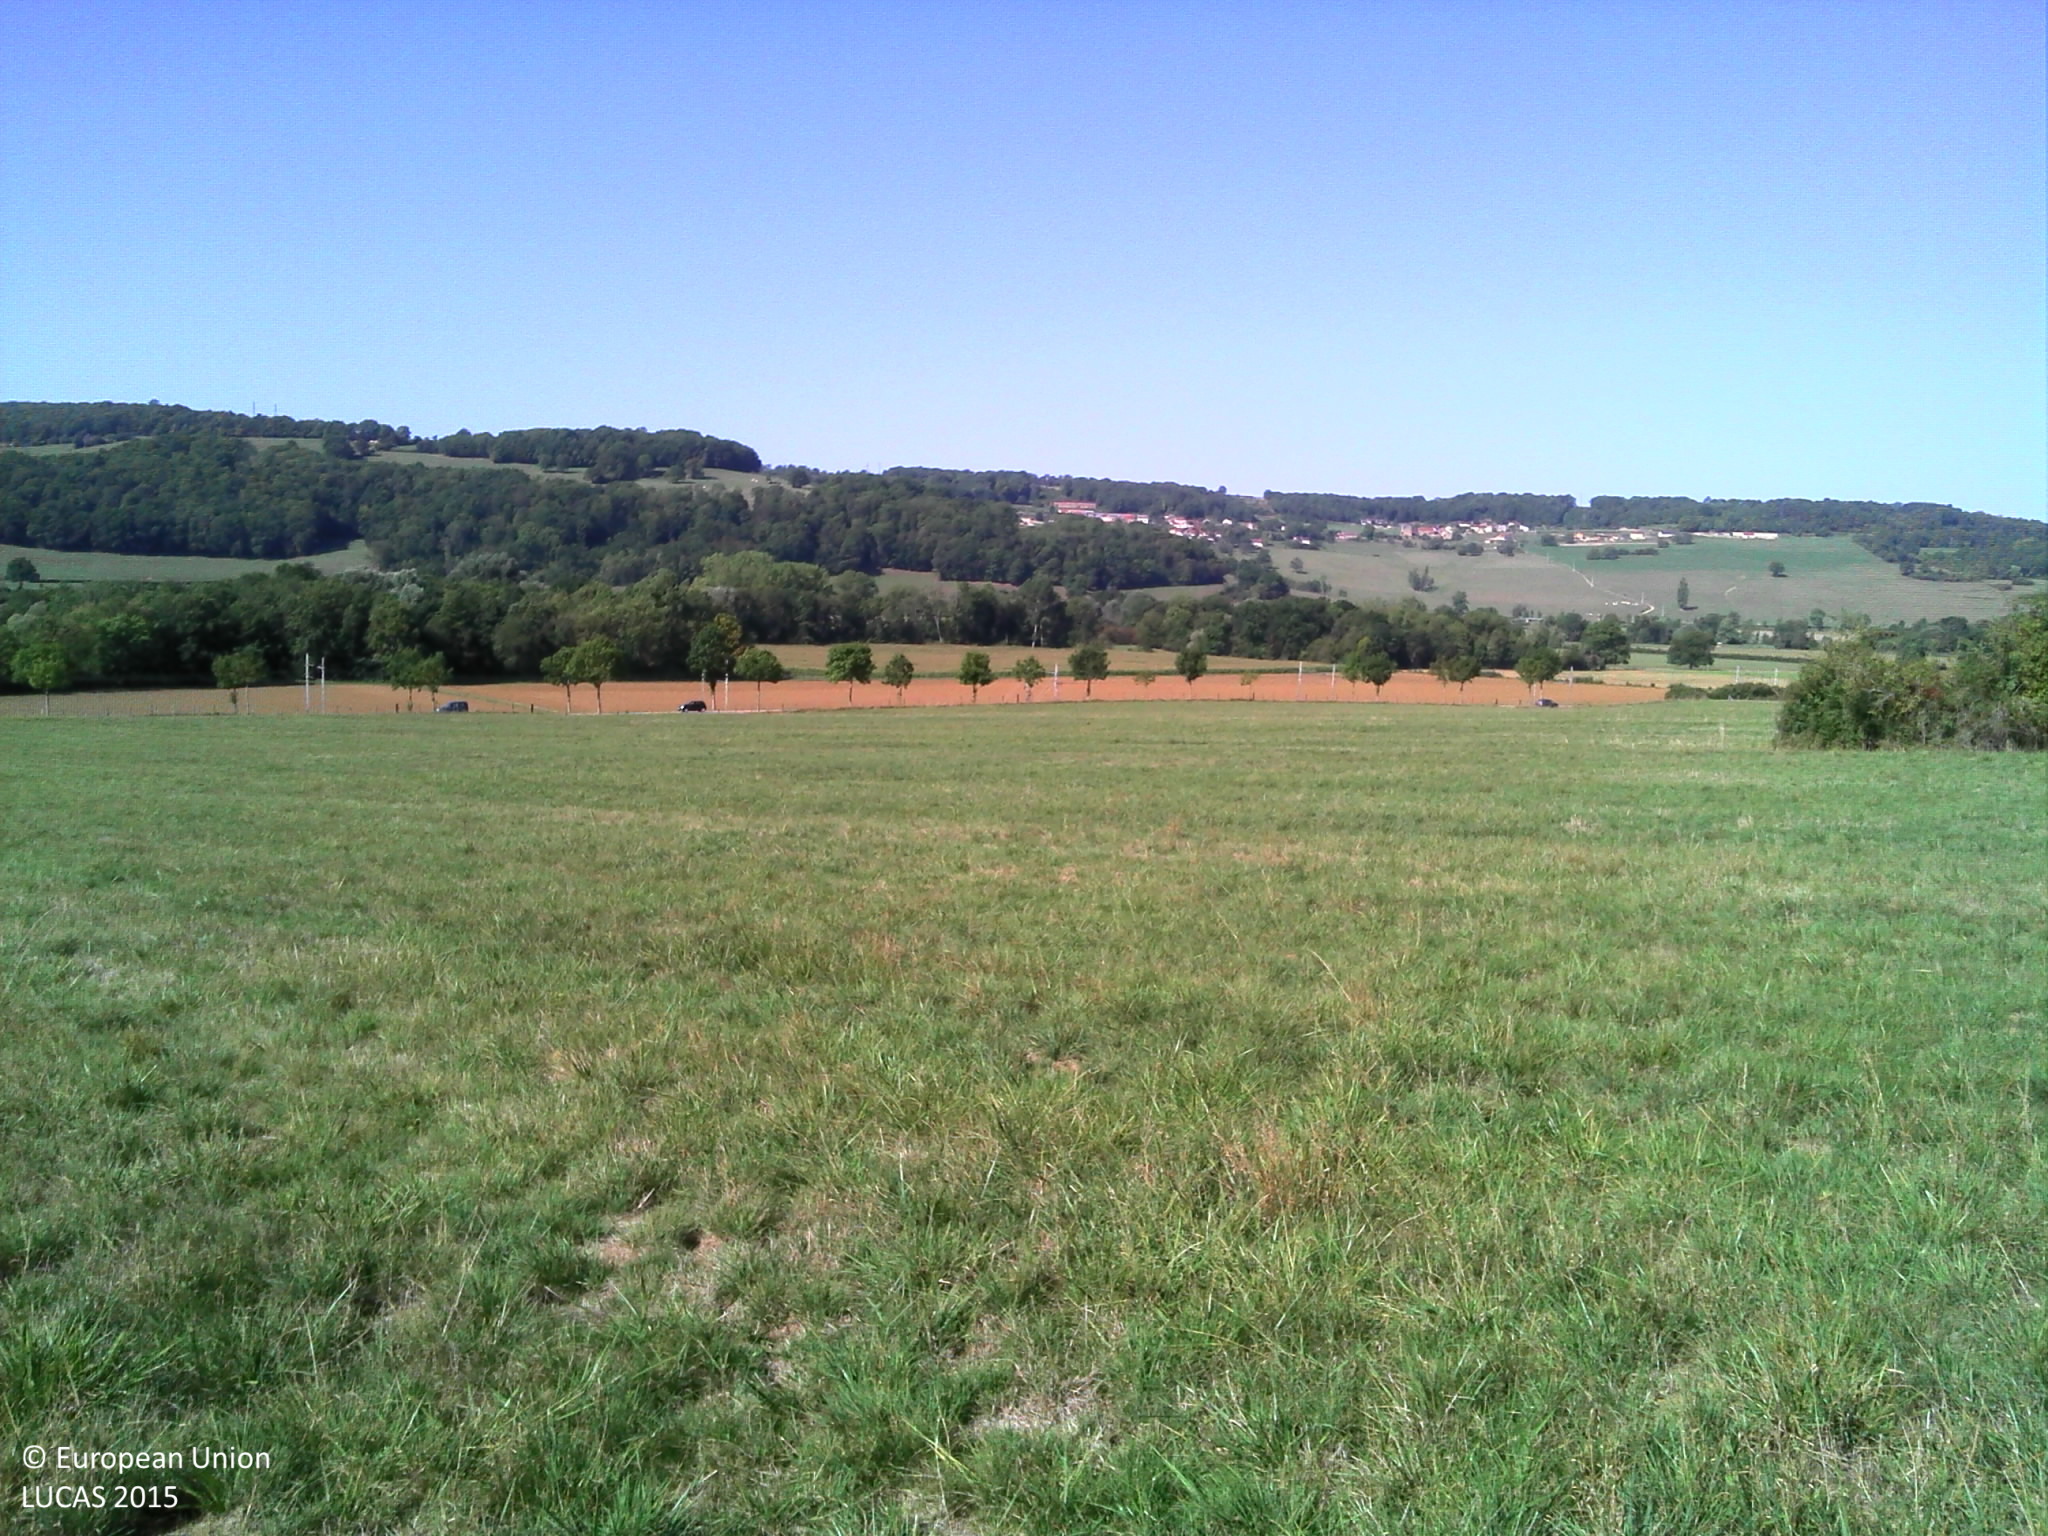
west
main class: Grassland
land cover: Grassland without tree/shrub cover
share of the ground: > 75 %
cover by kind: herbaceous plants 100 %
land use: Agriculture (excluding fallow land and kitchen gardens)
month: September
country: FR
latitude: 47.5776
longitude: 4.4283
